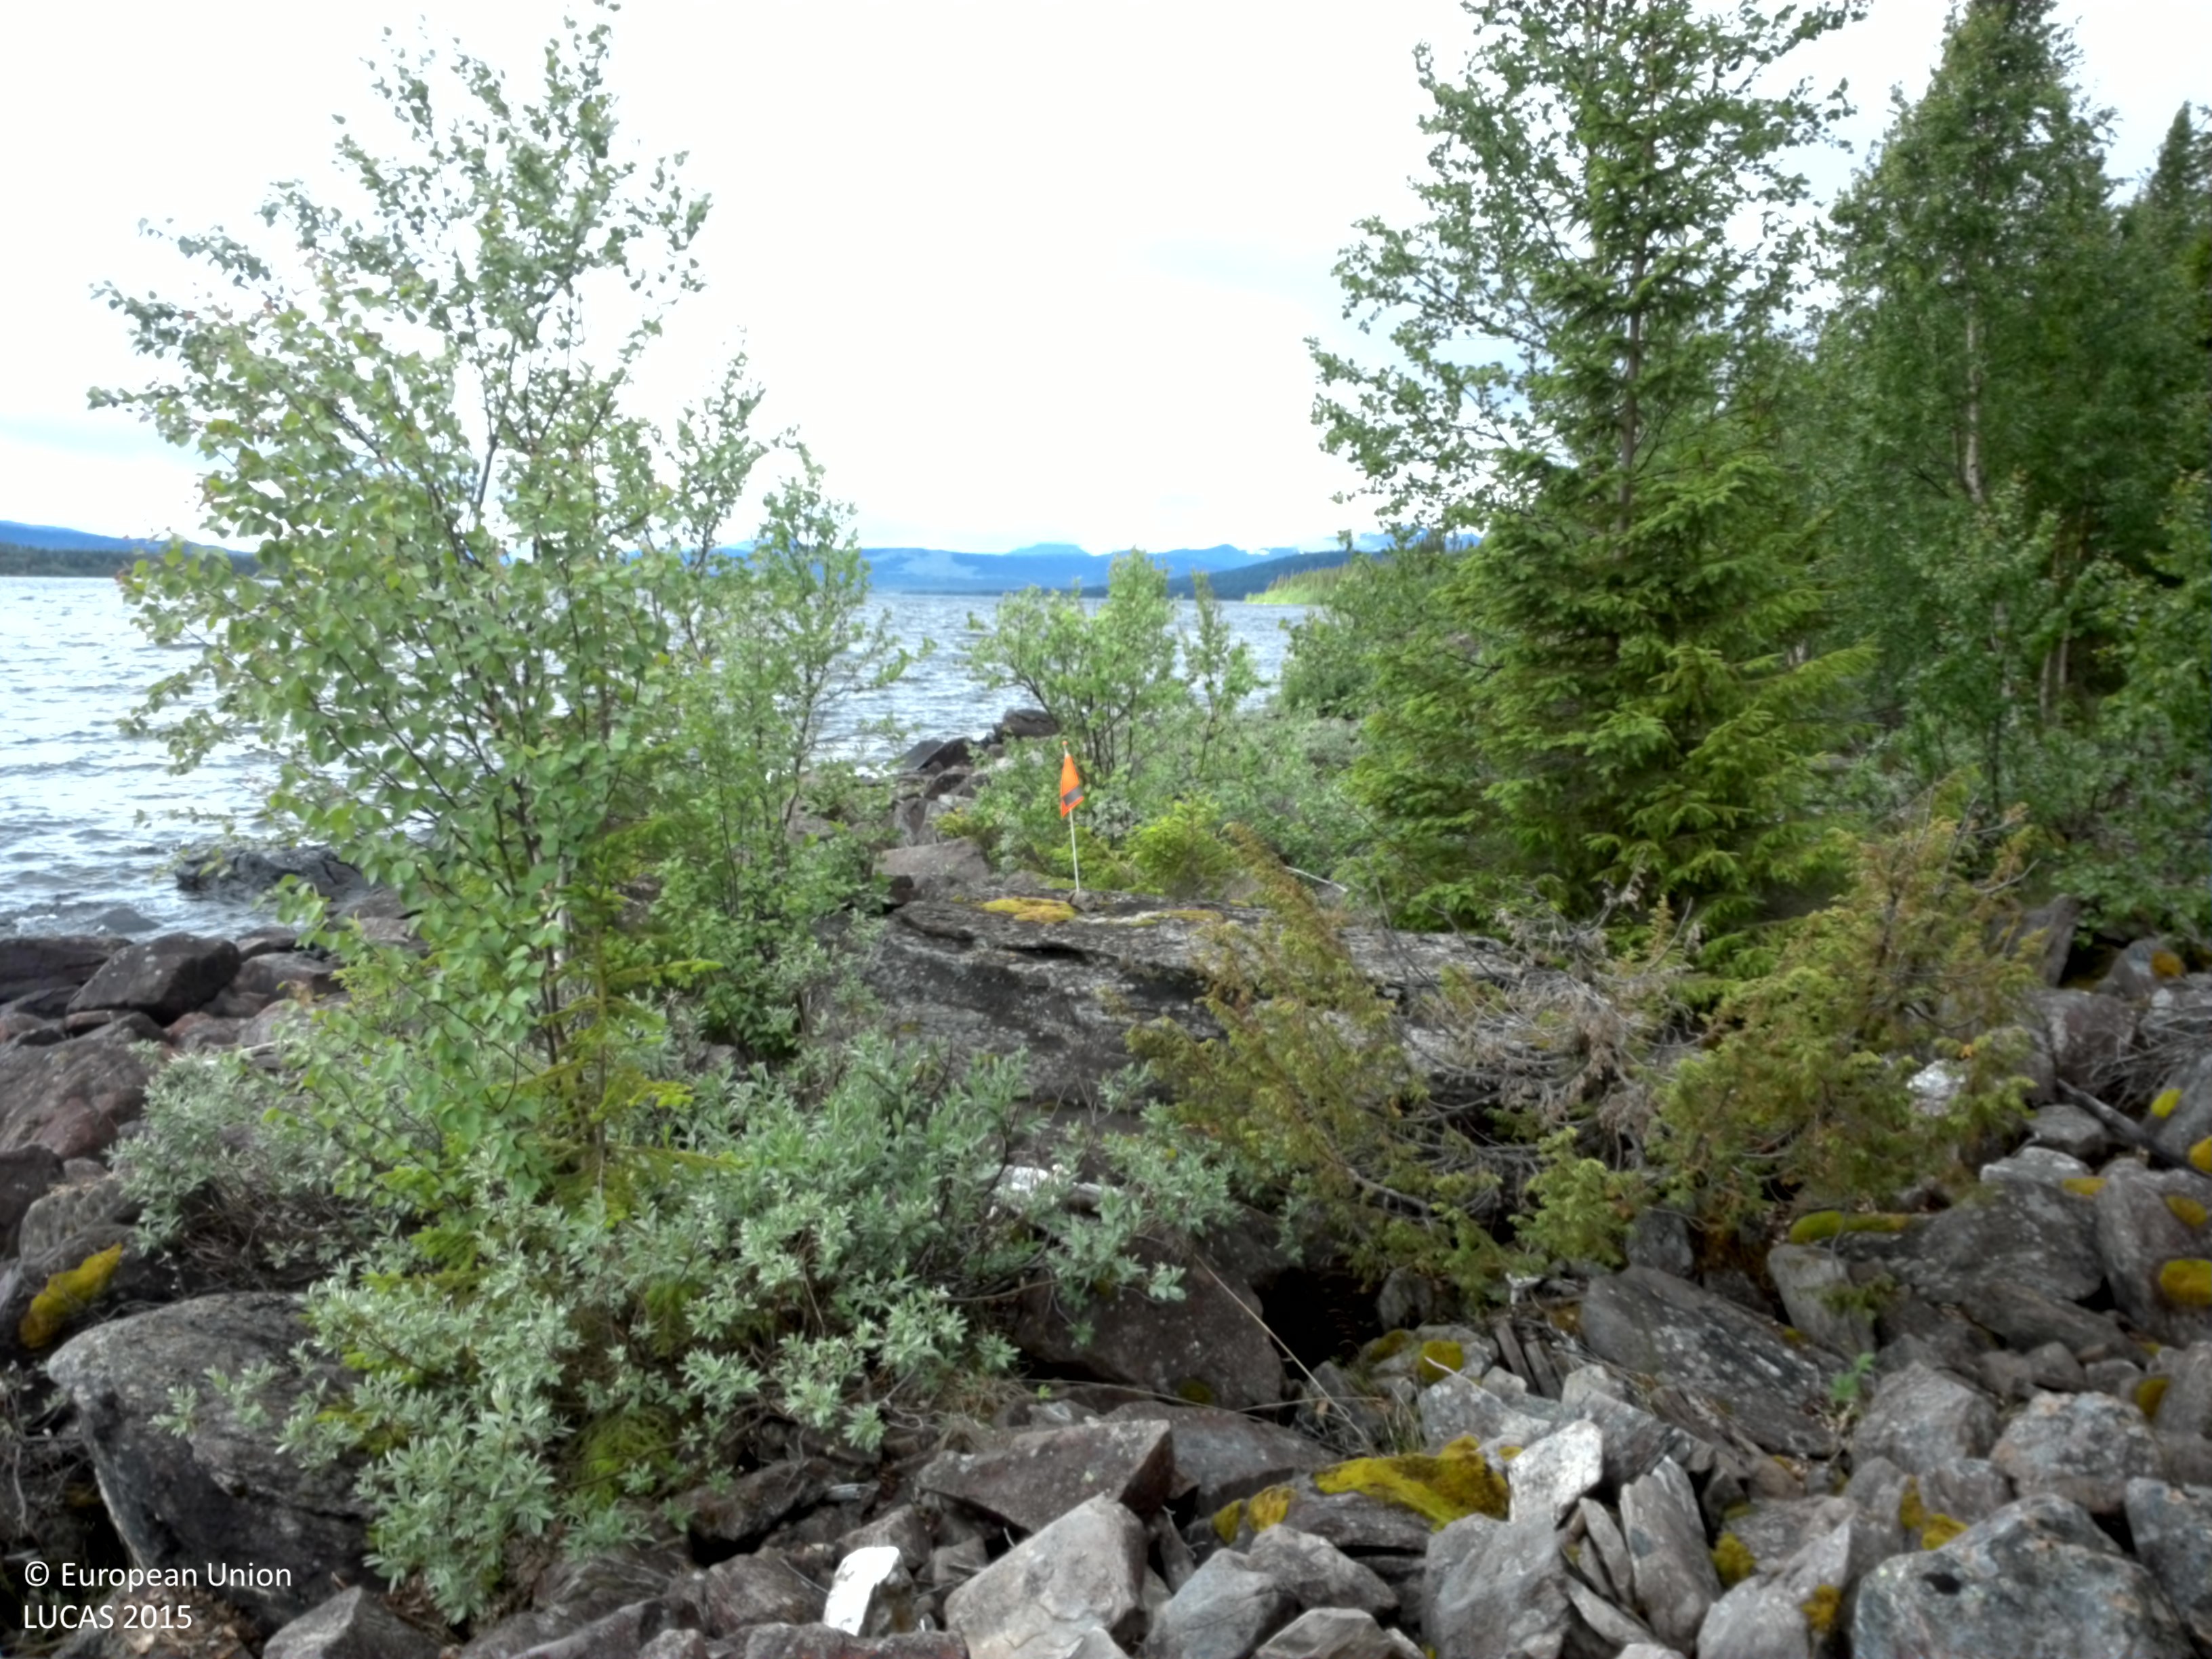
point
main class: Shrubland
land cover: Shrubland with sparse tree cover
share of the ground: 10 - 25 %
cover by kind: consolidated bare surface 85 %, shrubs 10 %, broadleaved forest trees 5 %
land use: Semi-natural and natural areas not in use
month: July
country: SE
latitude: 65.4406
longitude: 16.1081
